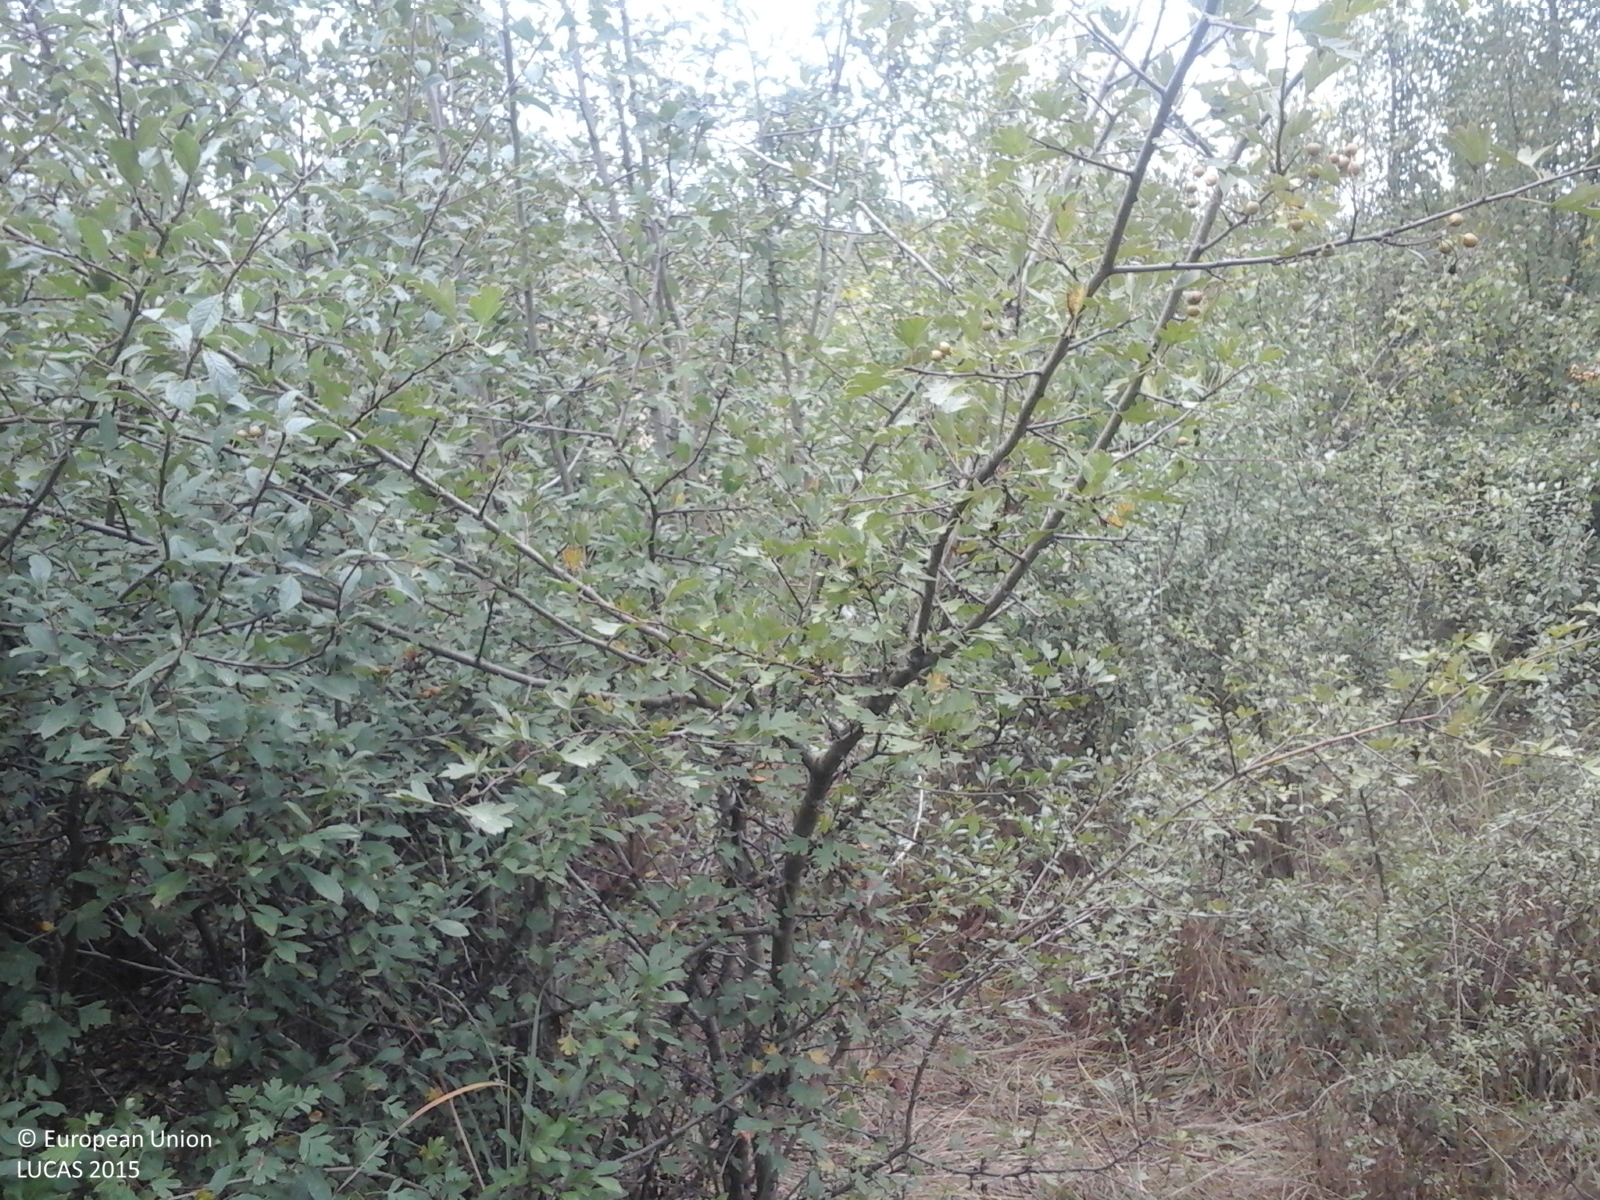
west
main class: Shrubland
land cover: Shrubland with sparse tree cover
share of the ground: > 75 %
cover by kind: herbaceous plants 70 %, shrubs 25 %, broadleaved forest trees 5 %
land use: Semi-natural and natural areas not in use
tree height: < 5 m
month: August
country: RO
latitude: 45.9121
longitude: 21.6522
